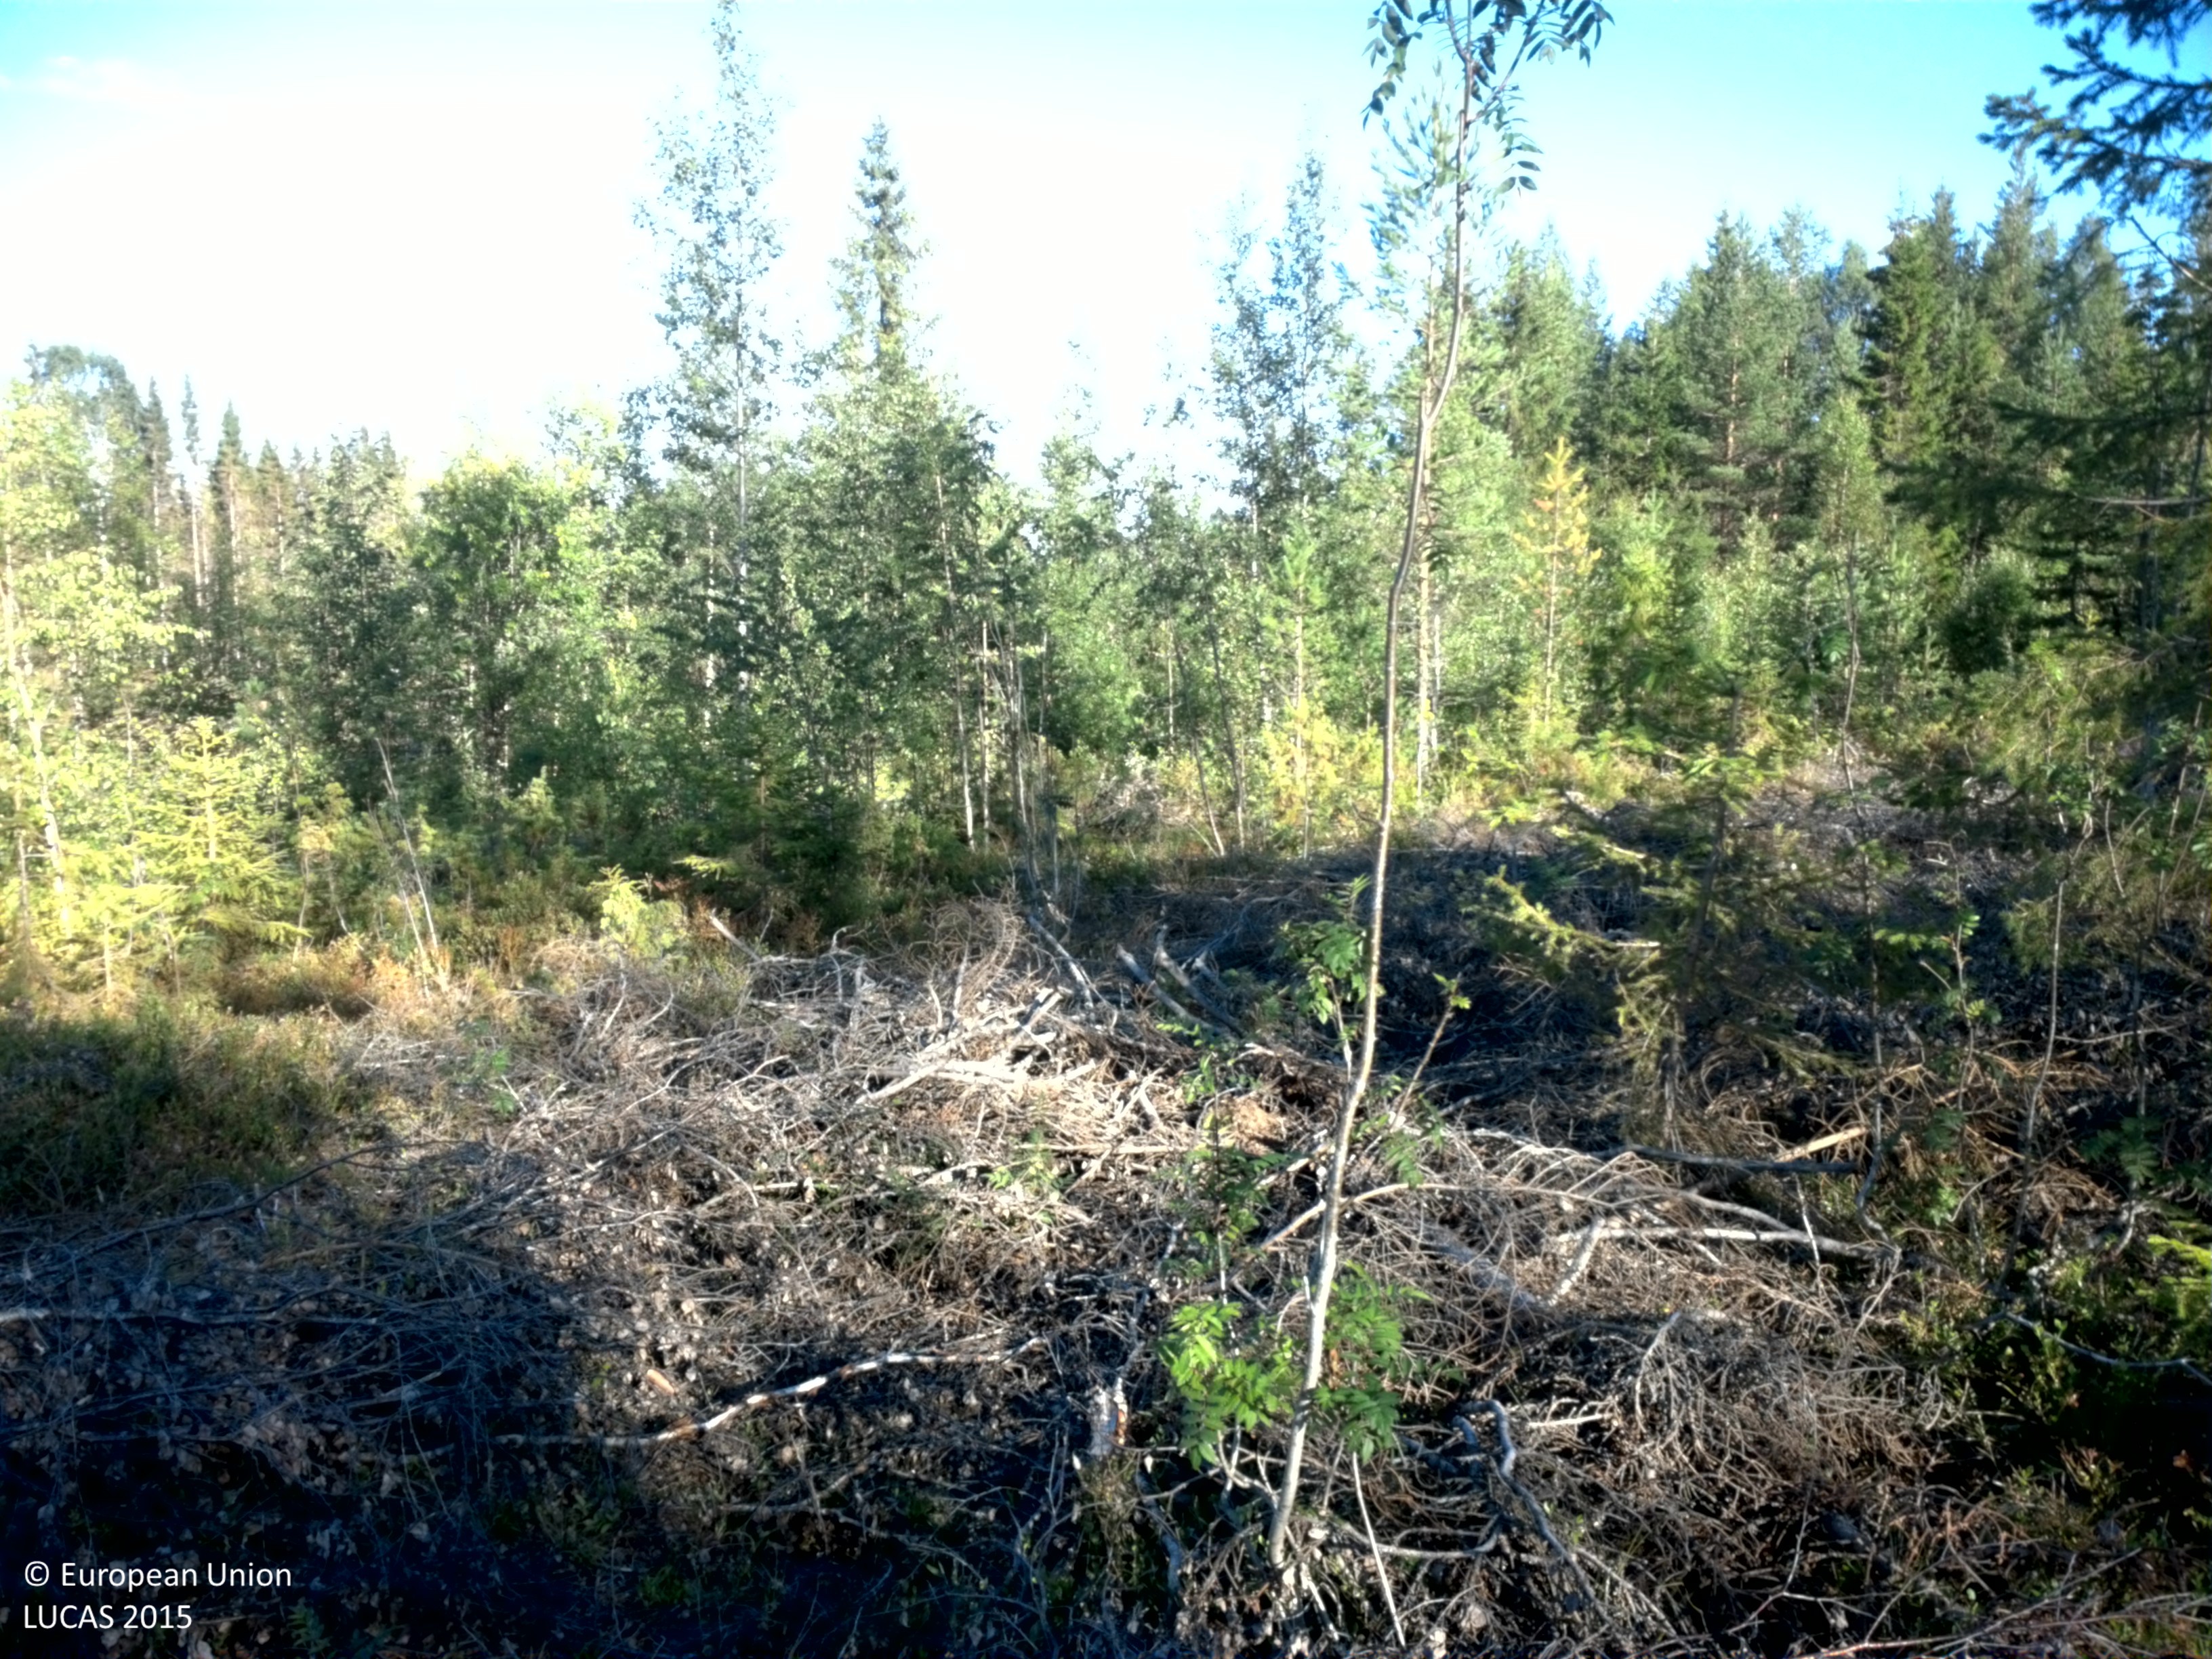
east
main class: Shrubland
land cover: Shrubland with sparse tree cover
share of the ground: > 75 %
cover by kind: shrubs 90 %, coniferous forest trees 5 %, herbaceous plants 5 %
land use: Forestry
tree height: < 5 m
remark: Clear cut
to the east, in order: Shrubland with sparse tree cover; Other mixed woodland; Ditches and canals; Grass margins; Paved roads, cycling and walking lanes; Broadleaved woodland; Shrubland with sparse tree cover; Spruce dominated coniferous woodland; Grassland with sparse tree/shrub cover; Broadleaved woodland
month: August
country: SE
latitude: 64.5674
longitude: 20.9364
